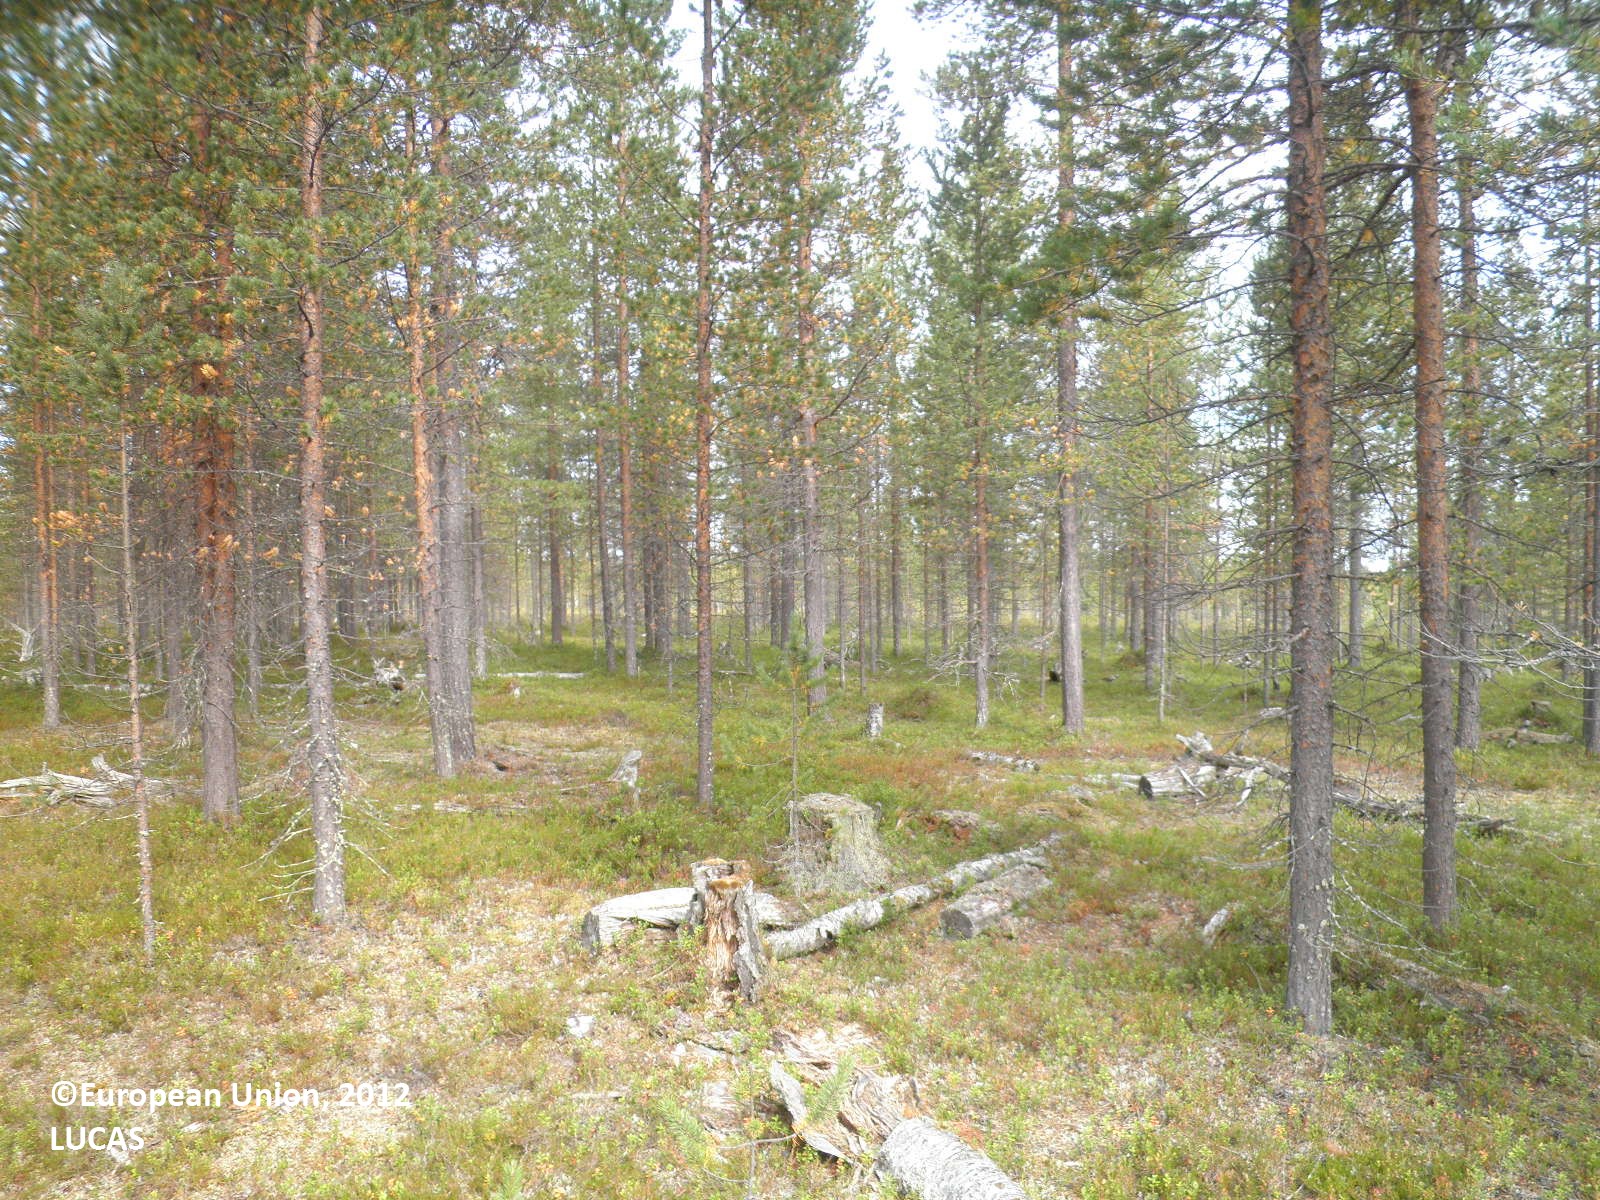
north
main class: Woodland
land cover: Pine dominated coniferous woodland
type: boreal forest
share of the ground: 50 - 75 %
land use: Forestry
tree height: > 5 m
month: August
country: FI
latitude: 67.7451
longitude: 28.9006
